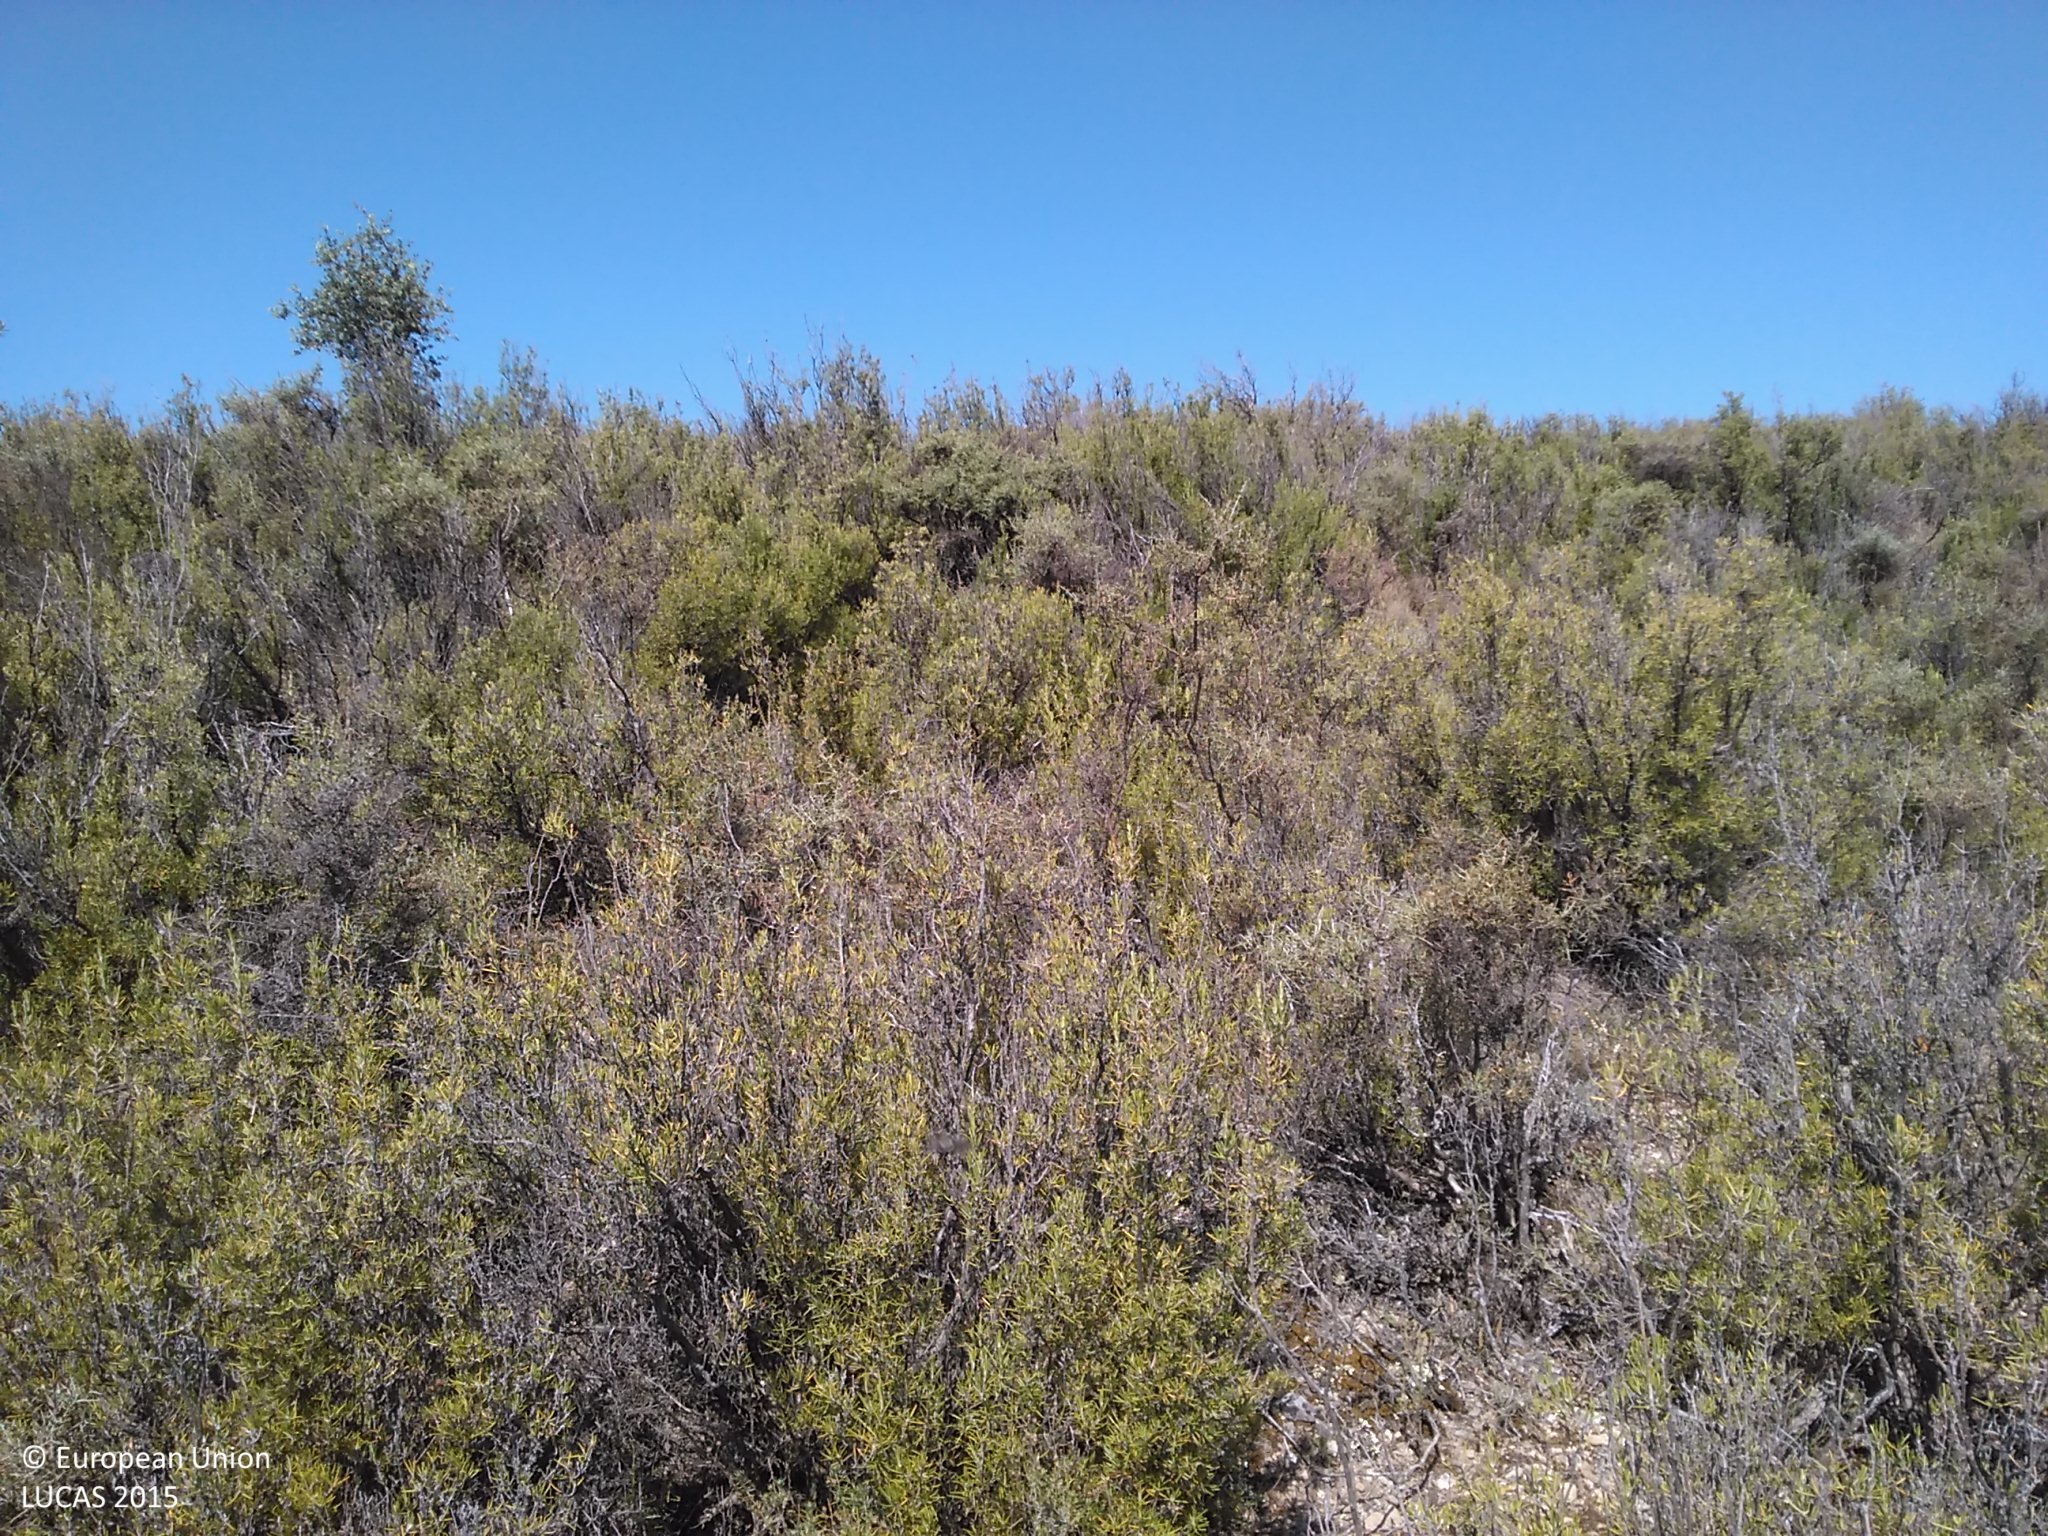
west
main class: Shrubland
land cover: Shrubland without tree cover
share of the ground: 50 - 75 %
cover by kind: shrubs 70 %, unconsolidated bare surface 25 %, herbaceous plants 5 %
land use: Semi-natural and natural areas not in use
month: July
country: ES
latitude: 41.4910
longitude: -1.9233
